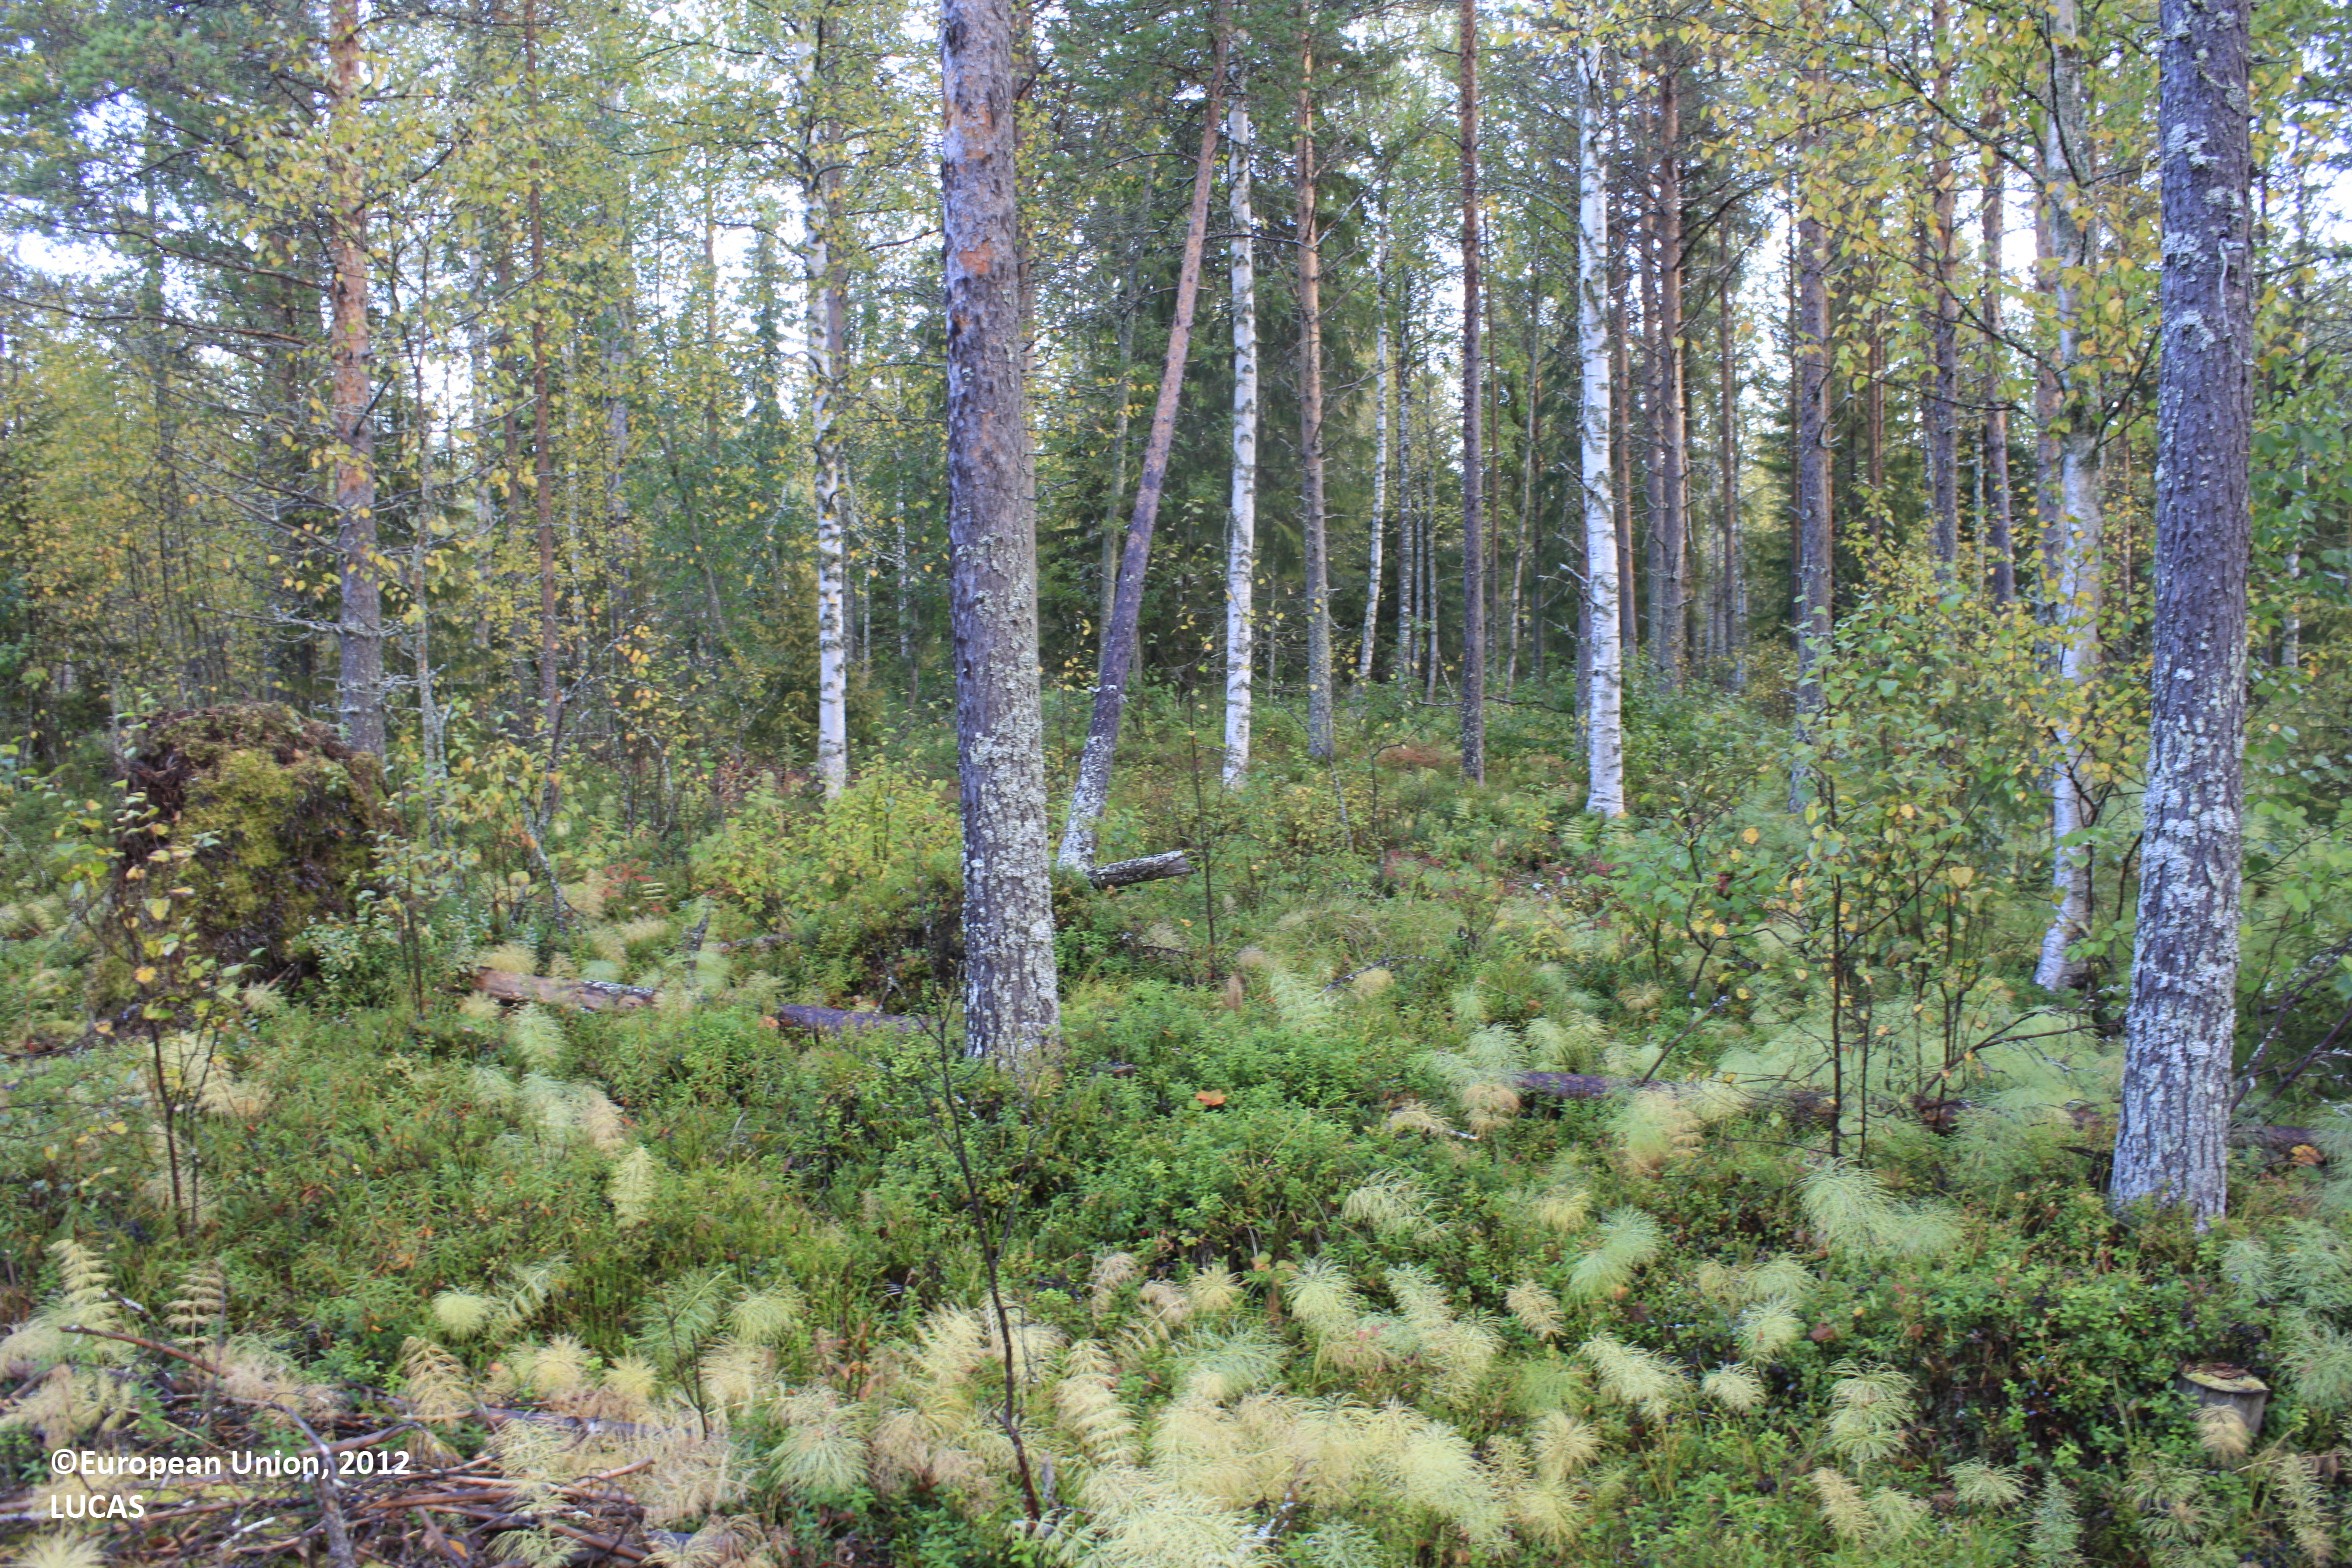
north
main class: Woodland
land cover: Pine dominated mixed woodland
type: boreal forest
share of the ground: 50 - 75 %
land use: Forestry
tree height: > 5 m
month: September
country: FI
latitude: 65.4797
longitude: 26.6246
